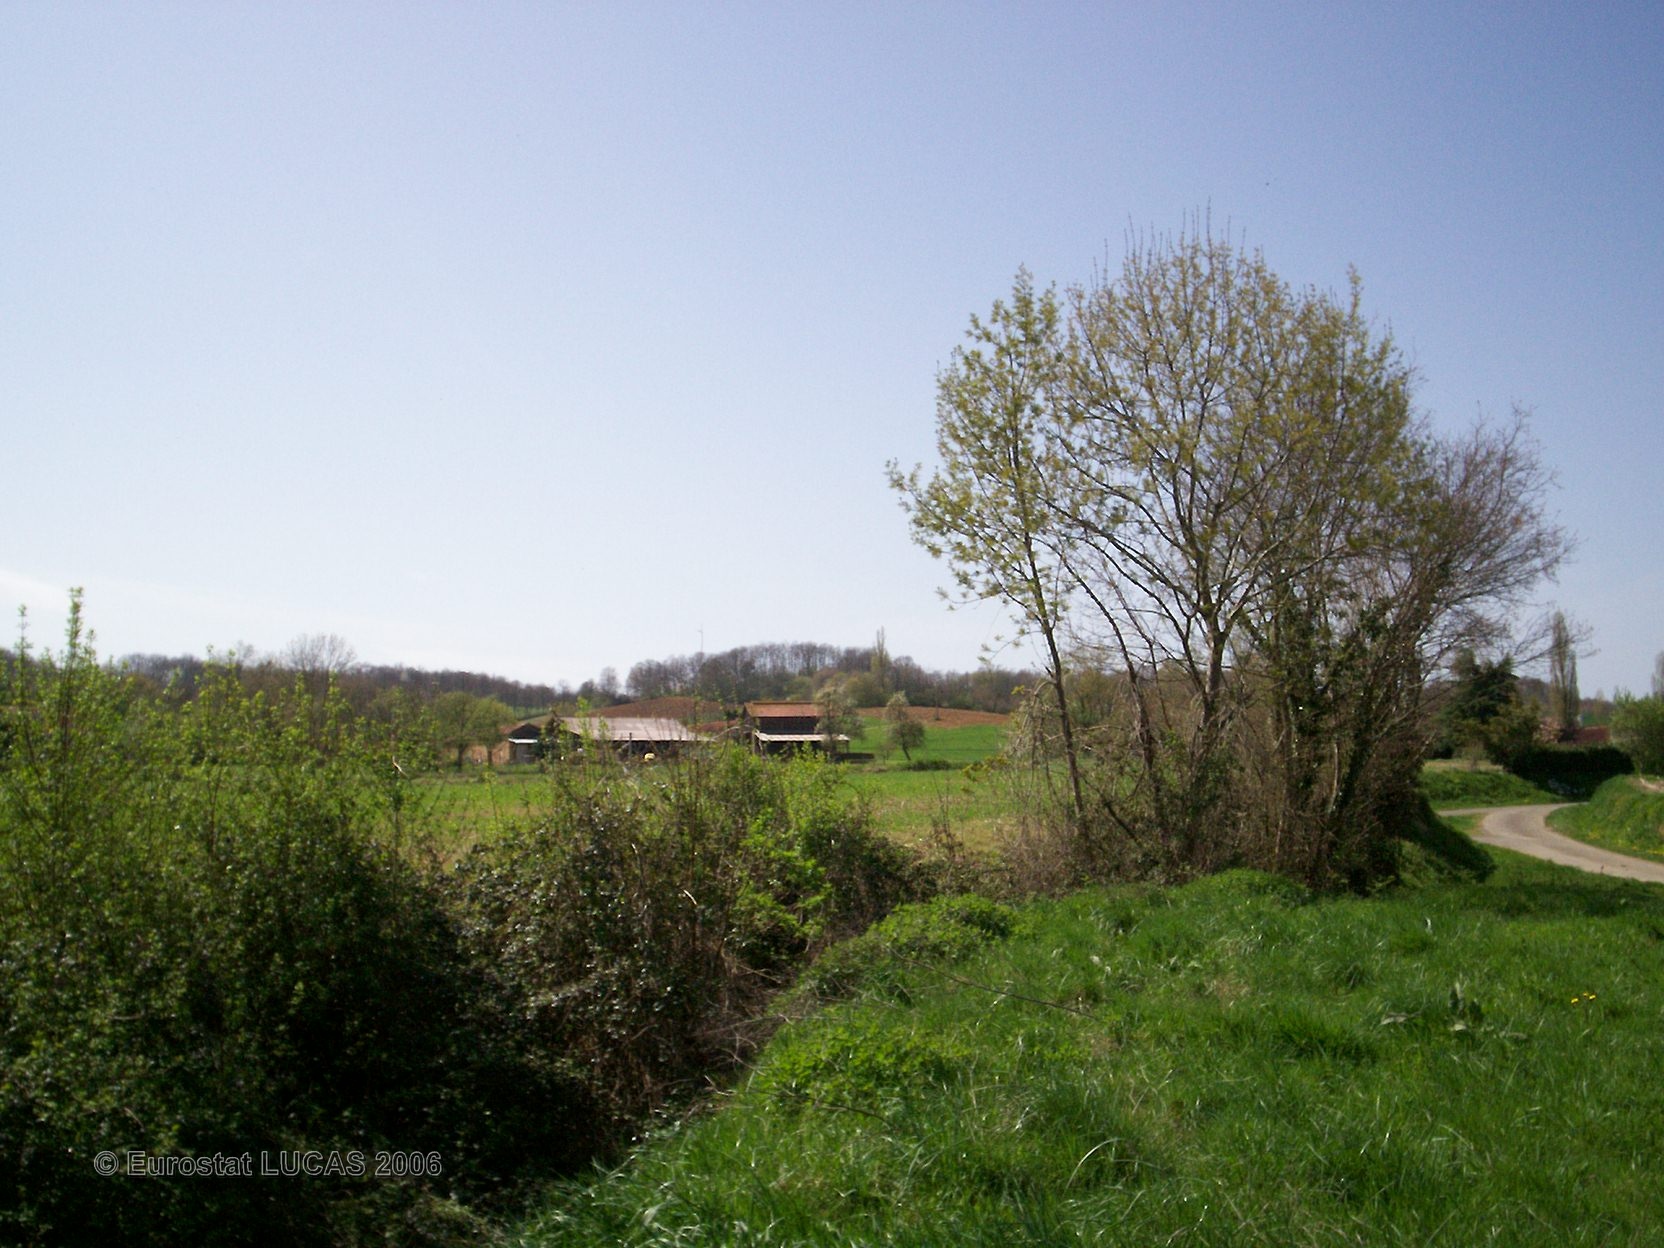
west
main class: Woodland
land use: Unused
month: April
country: FR
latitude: 43.3803
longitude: 0.2337
